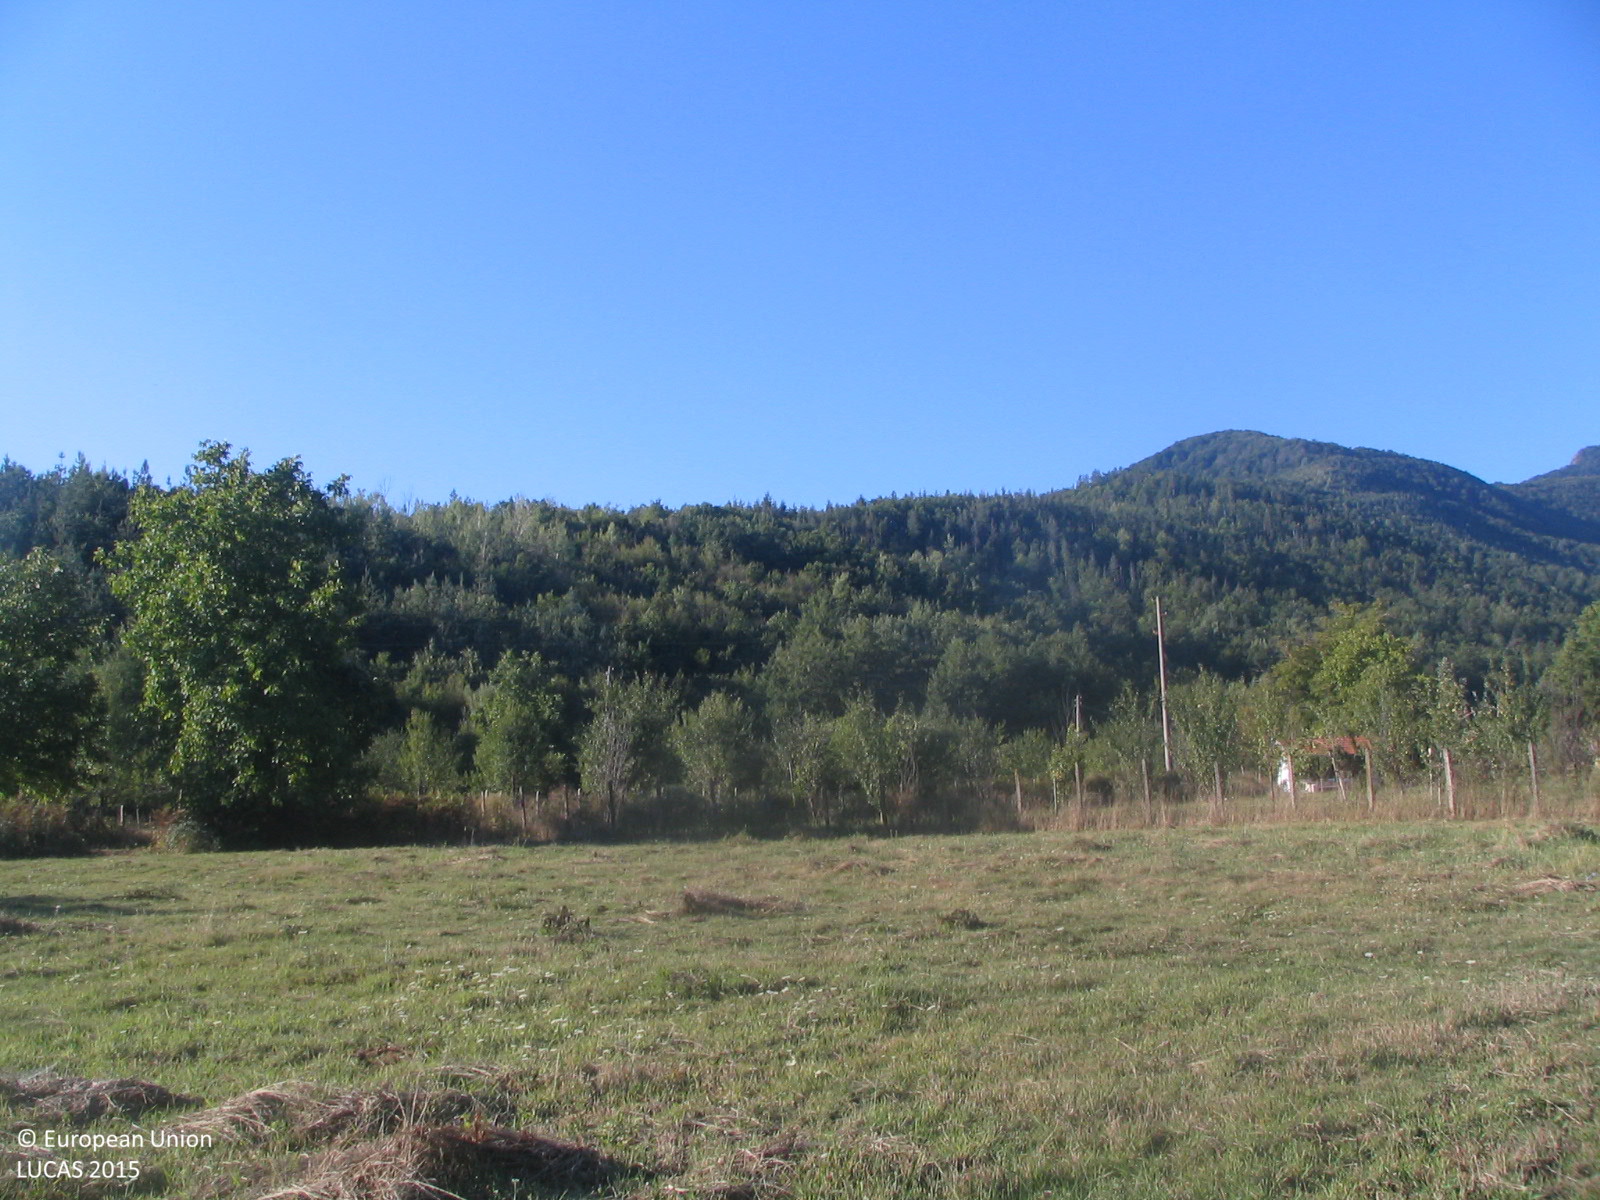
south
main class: Woodland
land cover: Broadleaved woodland
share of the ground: 50 - 75 %
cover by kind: broadleaved forest trees 60 %, shrubs 25 %, herbaceous plants 15 %
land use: Abandoned areas
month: September
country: BG
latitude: 42.9579
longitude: 24.3840
